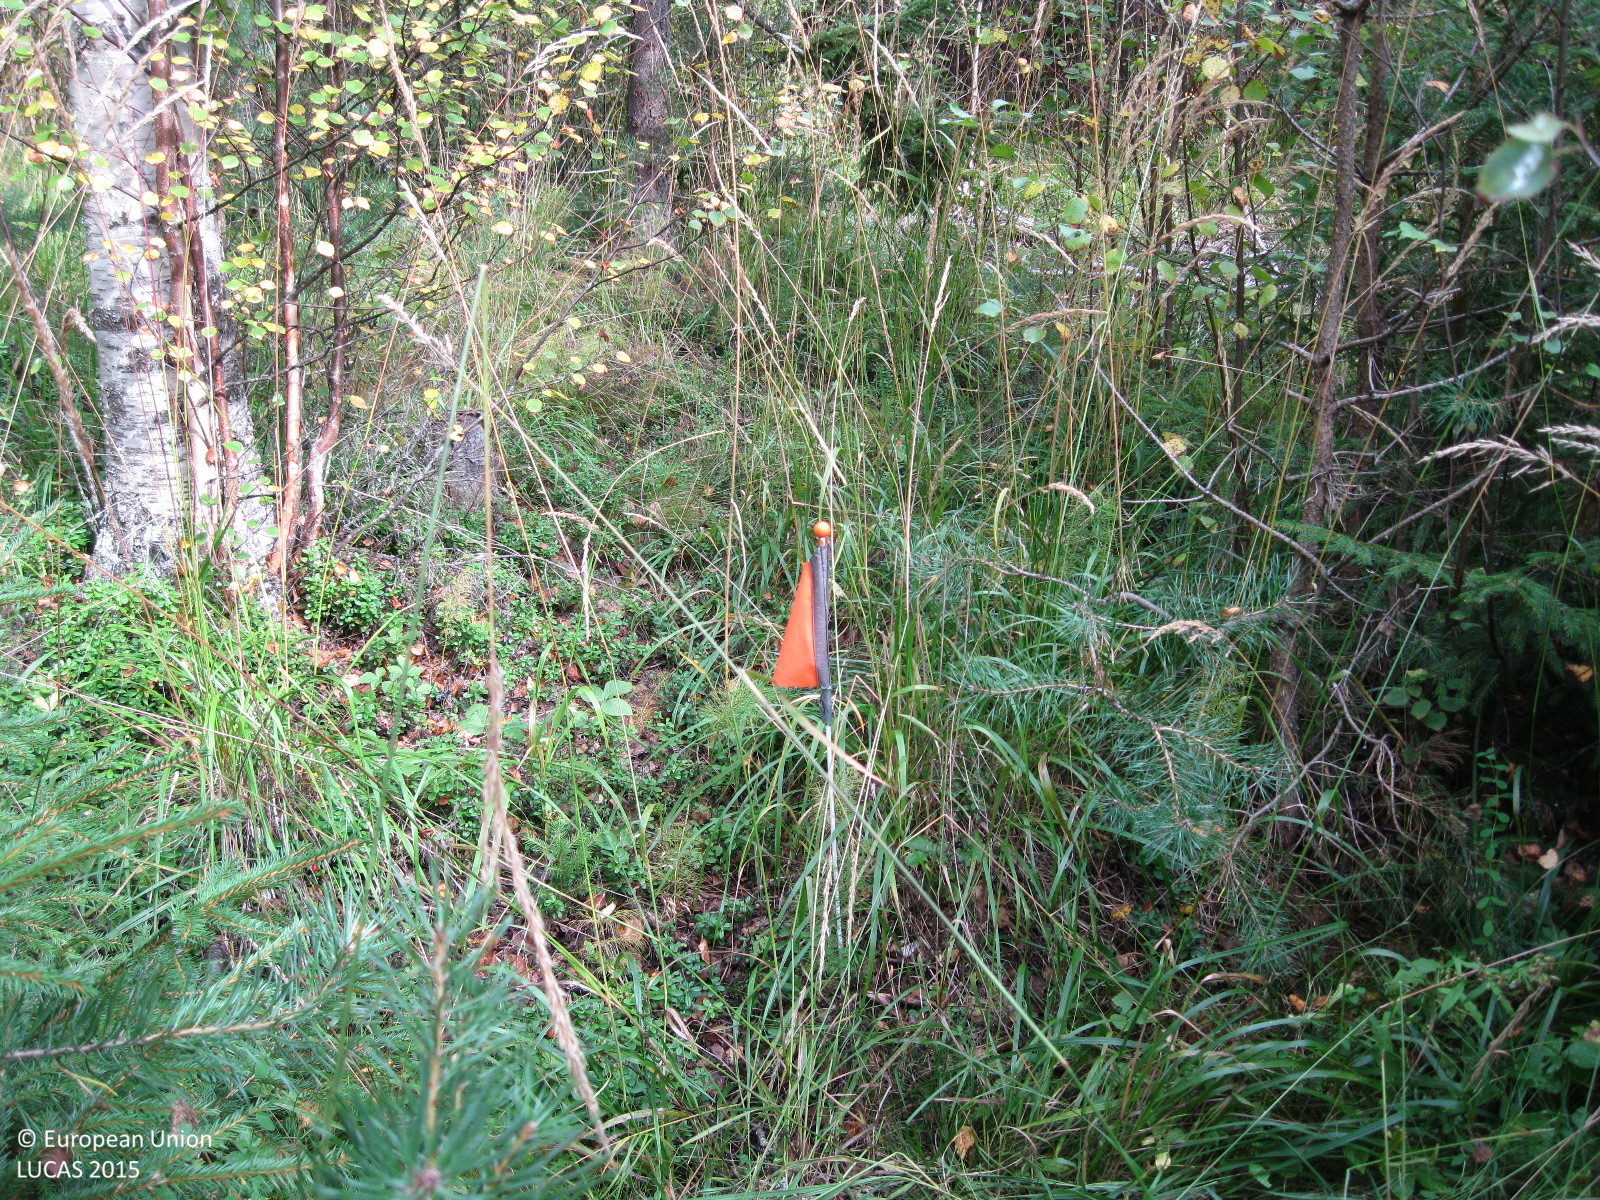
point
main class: Woodland
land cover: Spruce dominated mixed woodland
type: boreal forest
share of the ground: > 75 %
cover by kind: coniferous forest trees 45 %, broadleaved forest trees 35 %, shrubs 10 %, herbaceous plants 10 %
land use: Forestry
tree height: > 5 m
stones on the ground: < 10 %
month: September
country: FI
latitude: 60.7196
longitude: 24.9431
